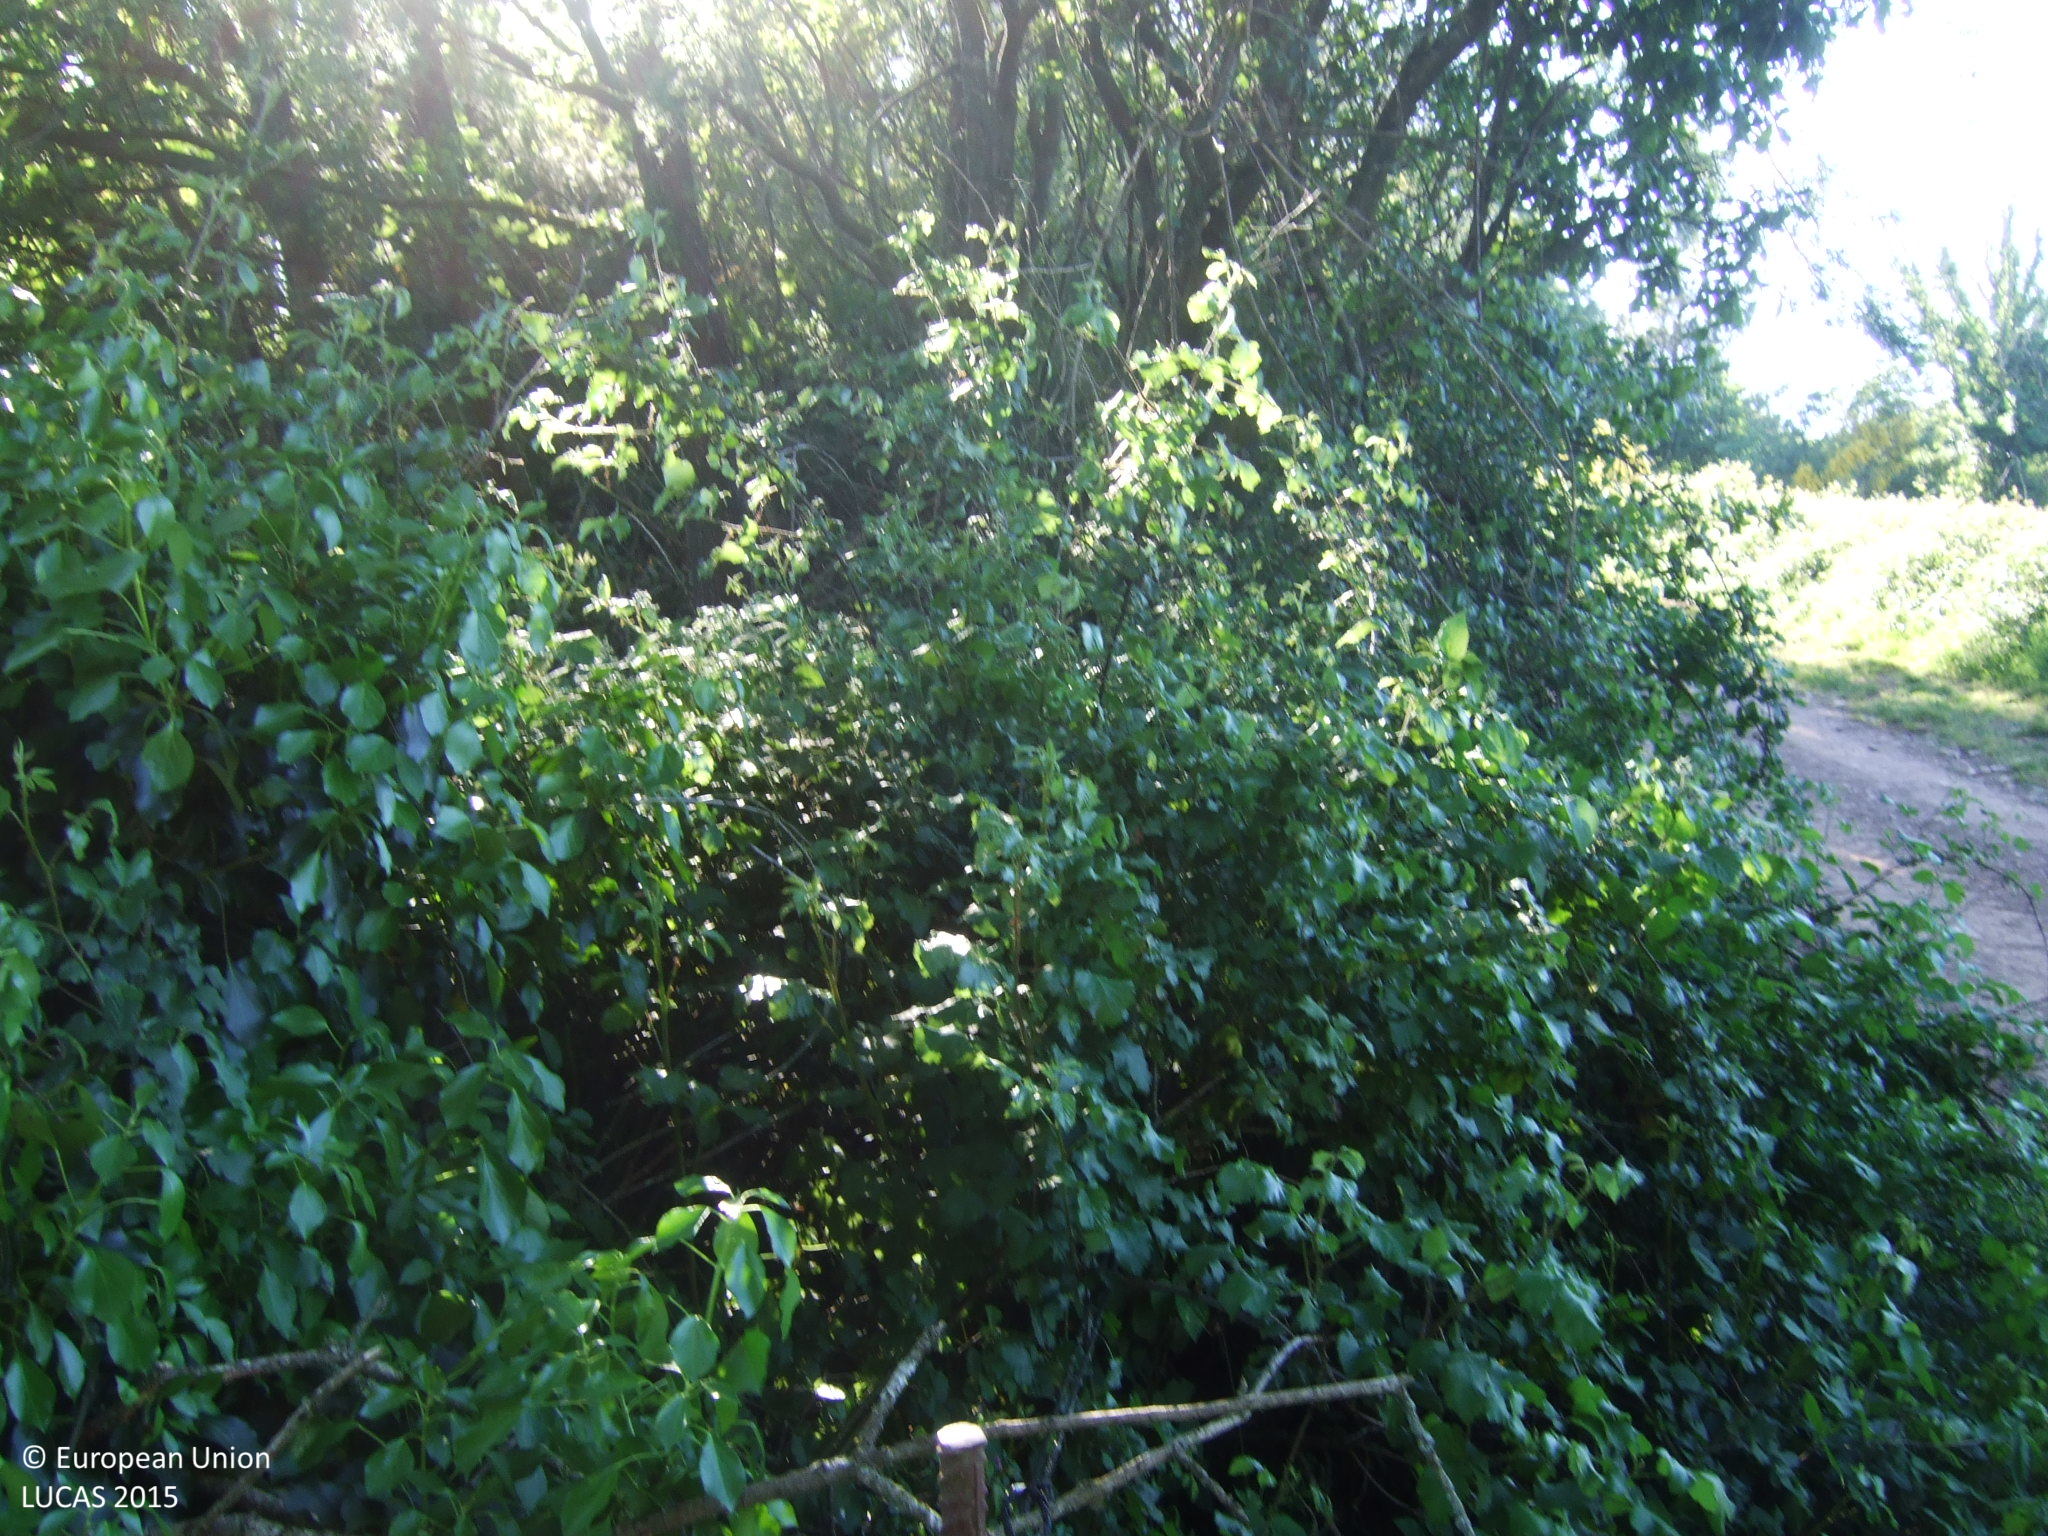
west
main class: Cropland
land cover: Other fresh vegetables
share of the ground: 25 - 50 %
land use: Kitchen garden
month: May
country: ES
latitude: 42.7122
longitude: -7.5455
